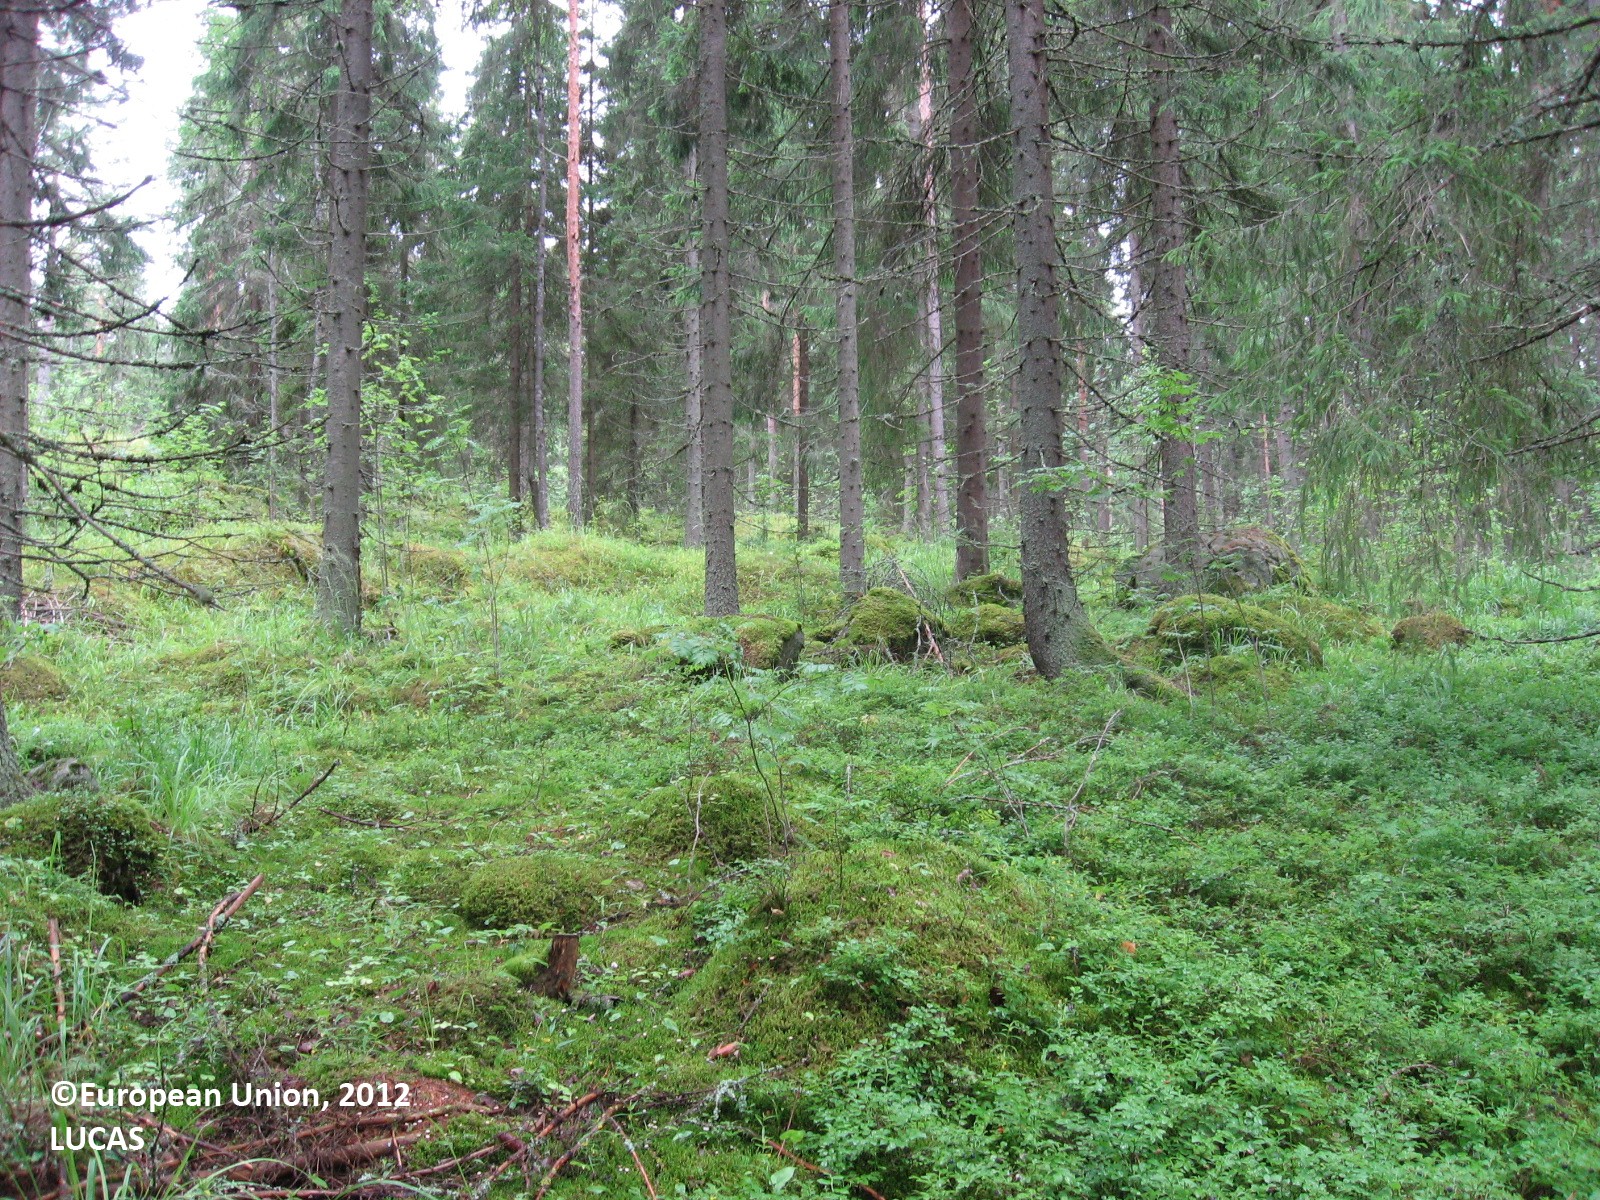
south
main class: Woodland
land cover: Spruce dominated coniferous woodland
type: boreal forest
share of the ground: 50 - 75 %
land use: Forestry
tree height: > 5 m
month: July
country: FI
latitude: 61.2271
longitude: 25.8700
